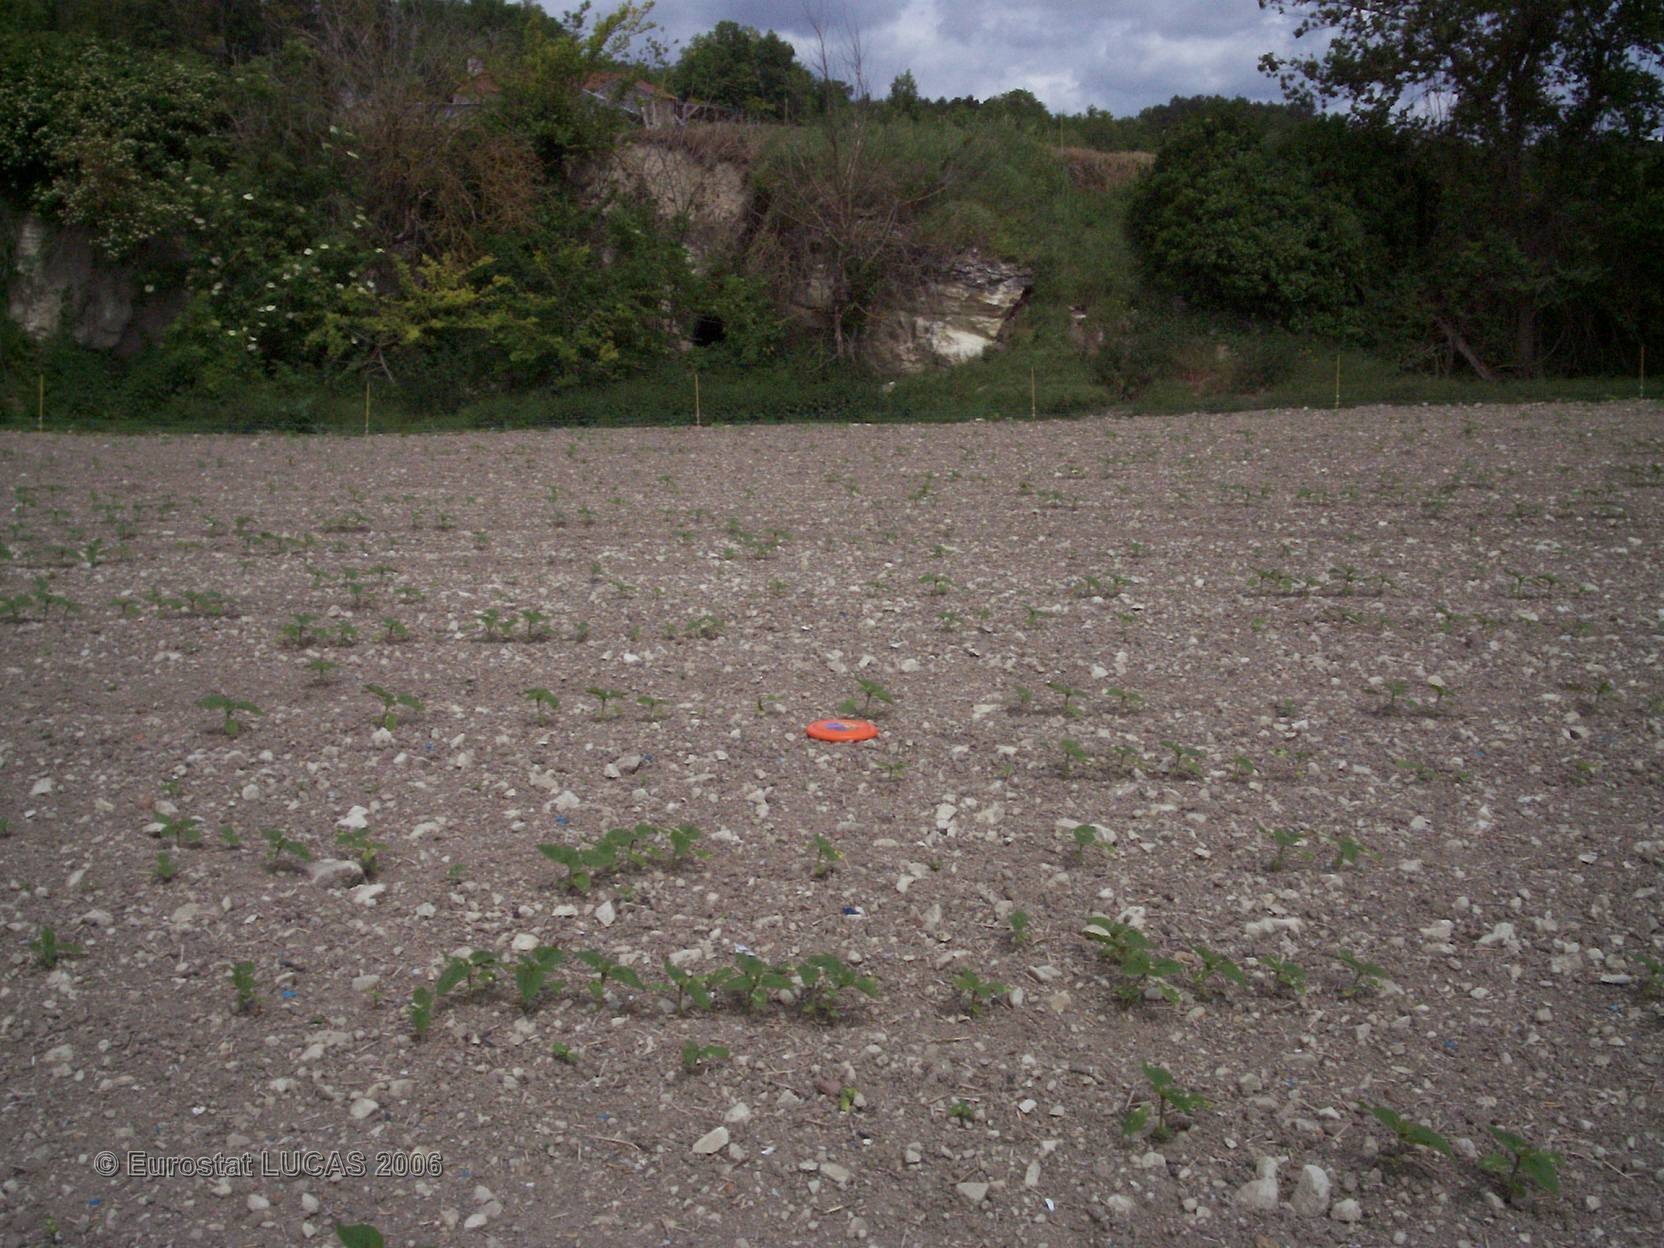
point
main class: Cropland
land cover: Sunflower
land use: Agriculture (excluding fallow land and kitchen gardens)
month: May
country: FR
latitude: 46.8272
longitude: 0.4241
